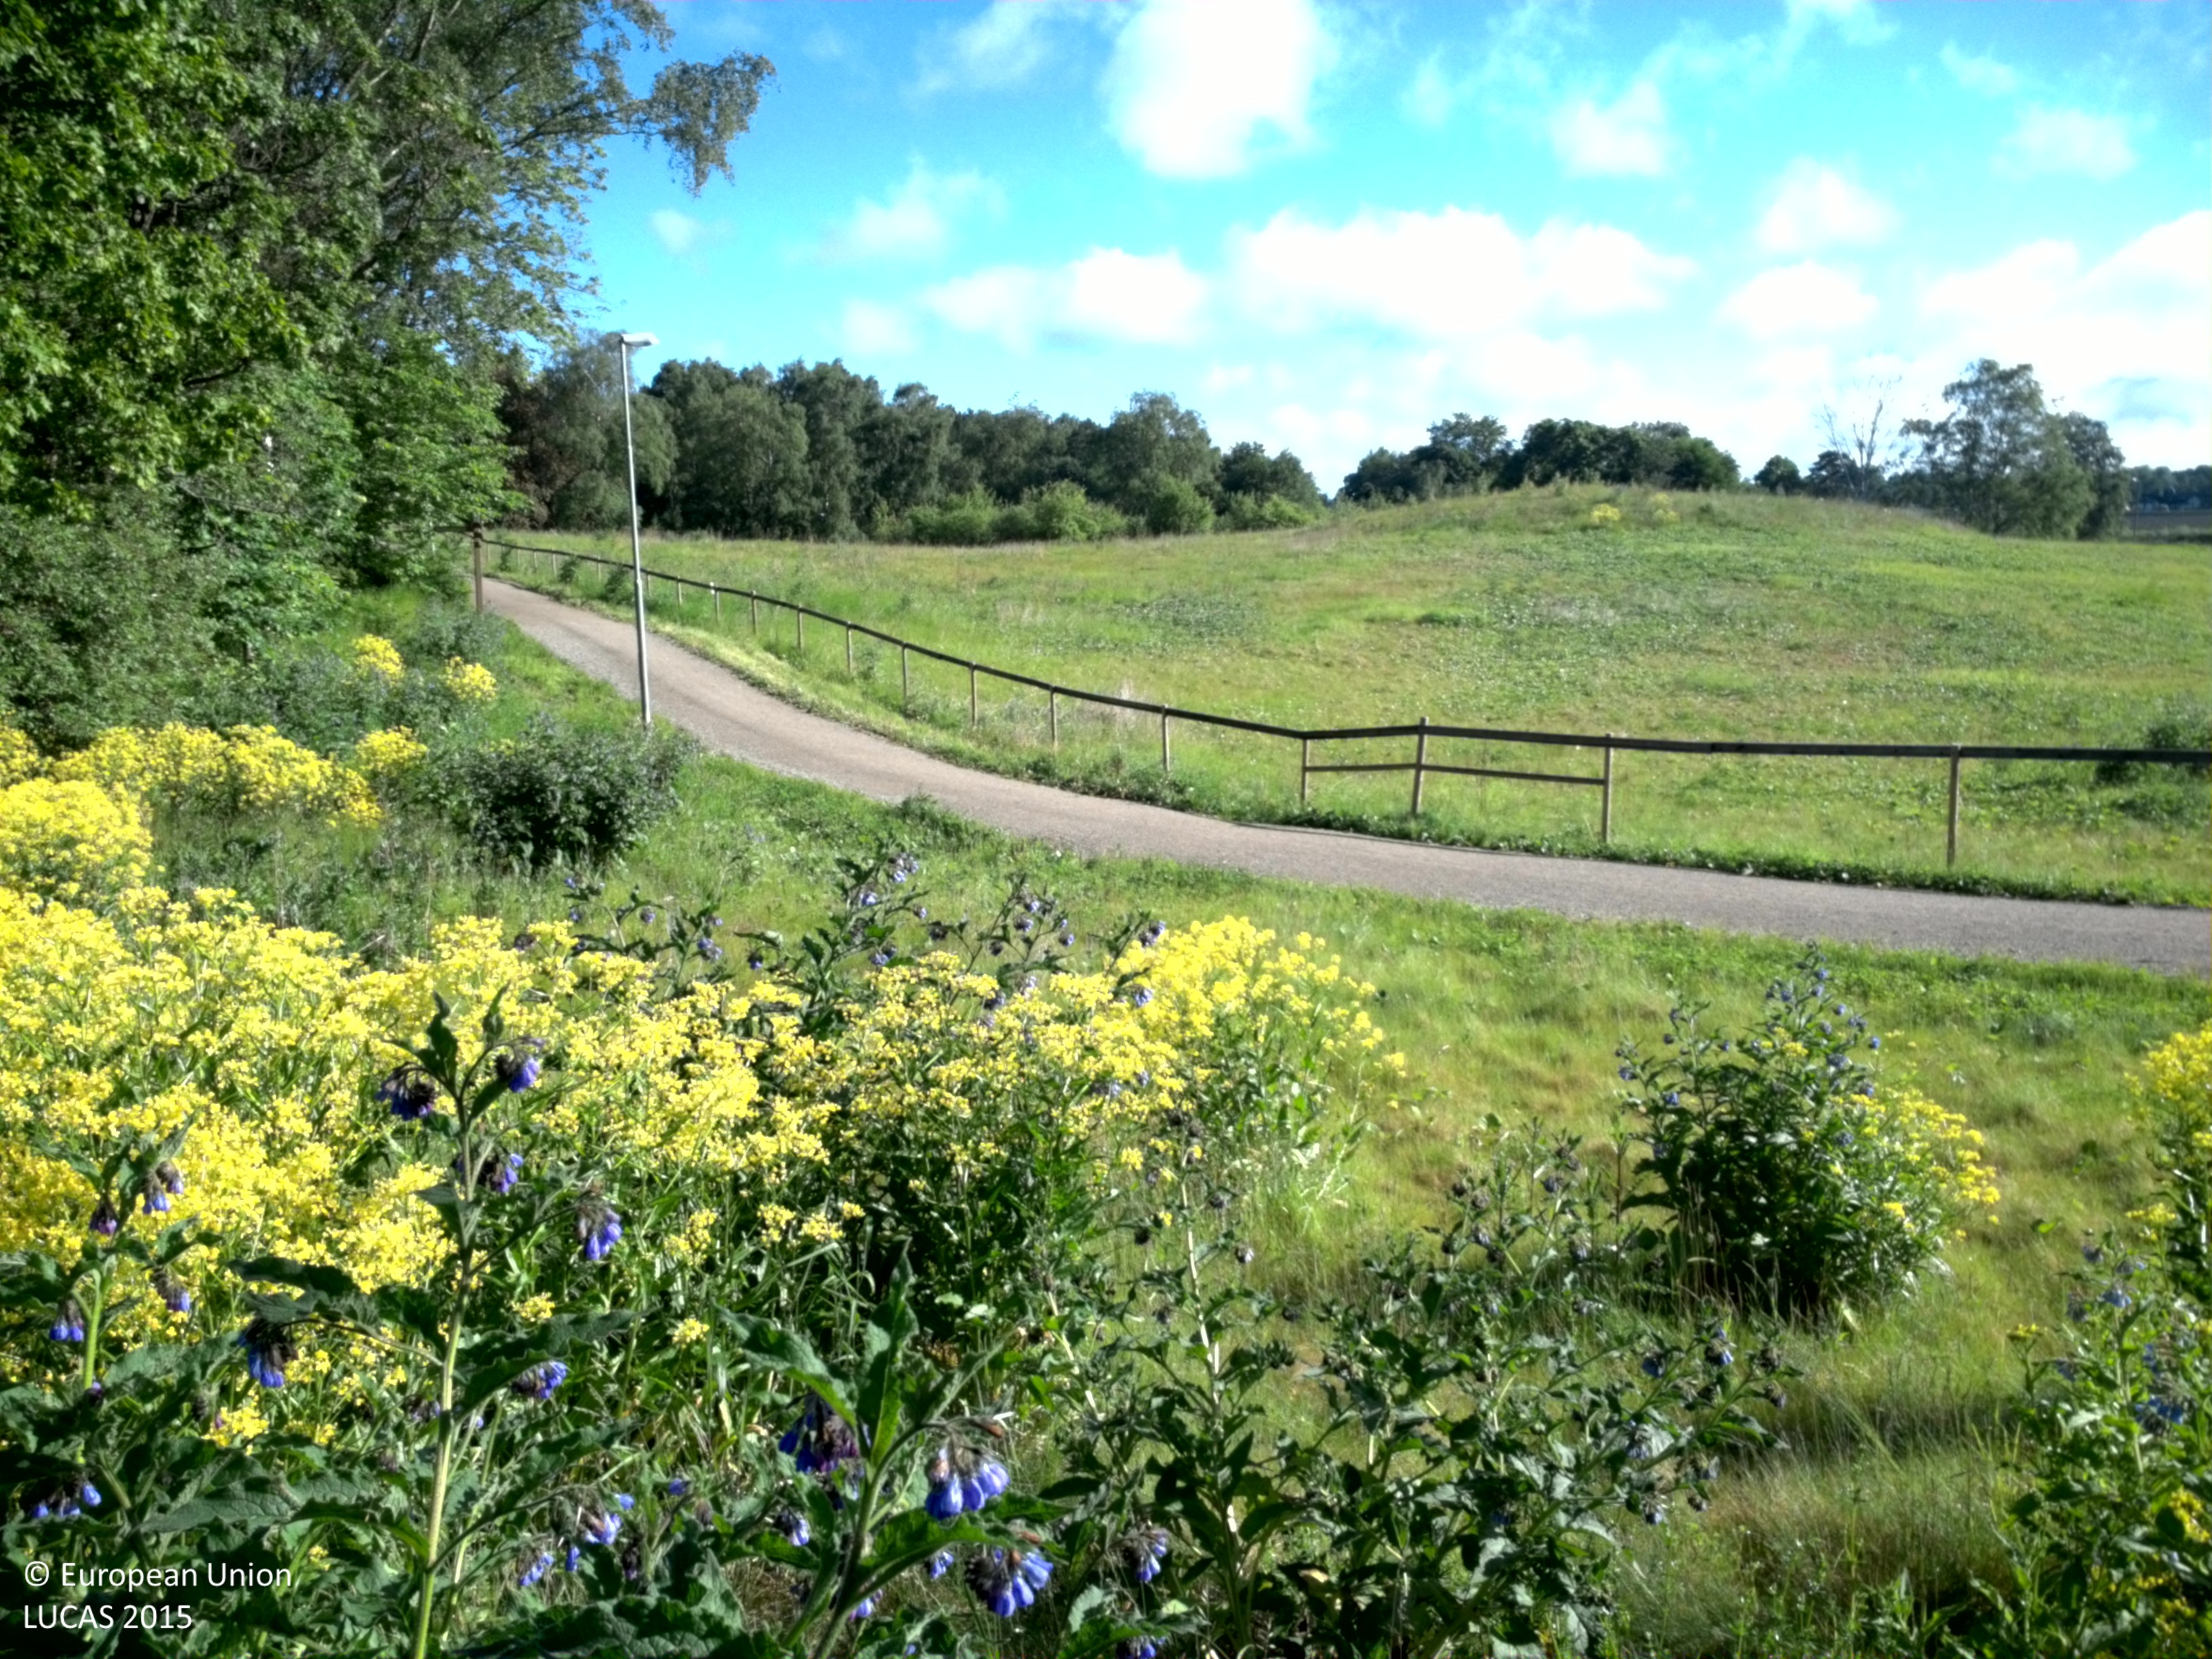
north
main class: Grassland
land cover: Grassland without tree/shrub cover
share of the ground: > 75 %
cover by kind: herbaceous plants 95 %, shrubs 5 %
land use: Semi-natural and natural areas not in use
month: June
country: SE
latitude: 59.8839
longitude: 17.6237
